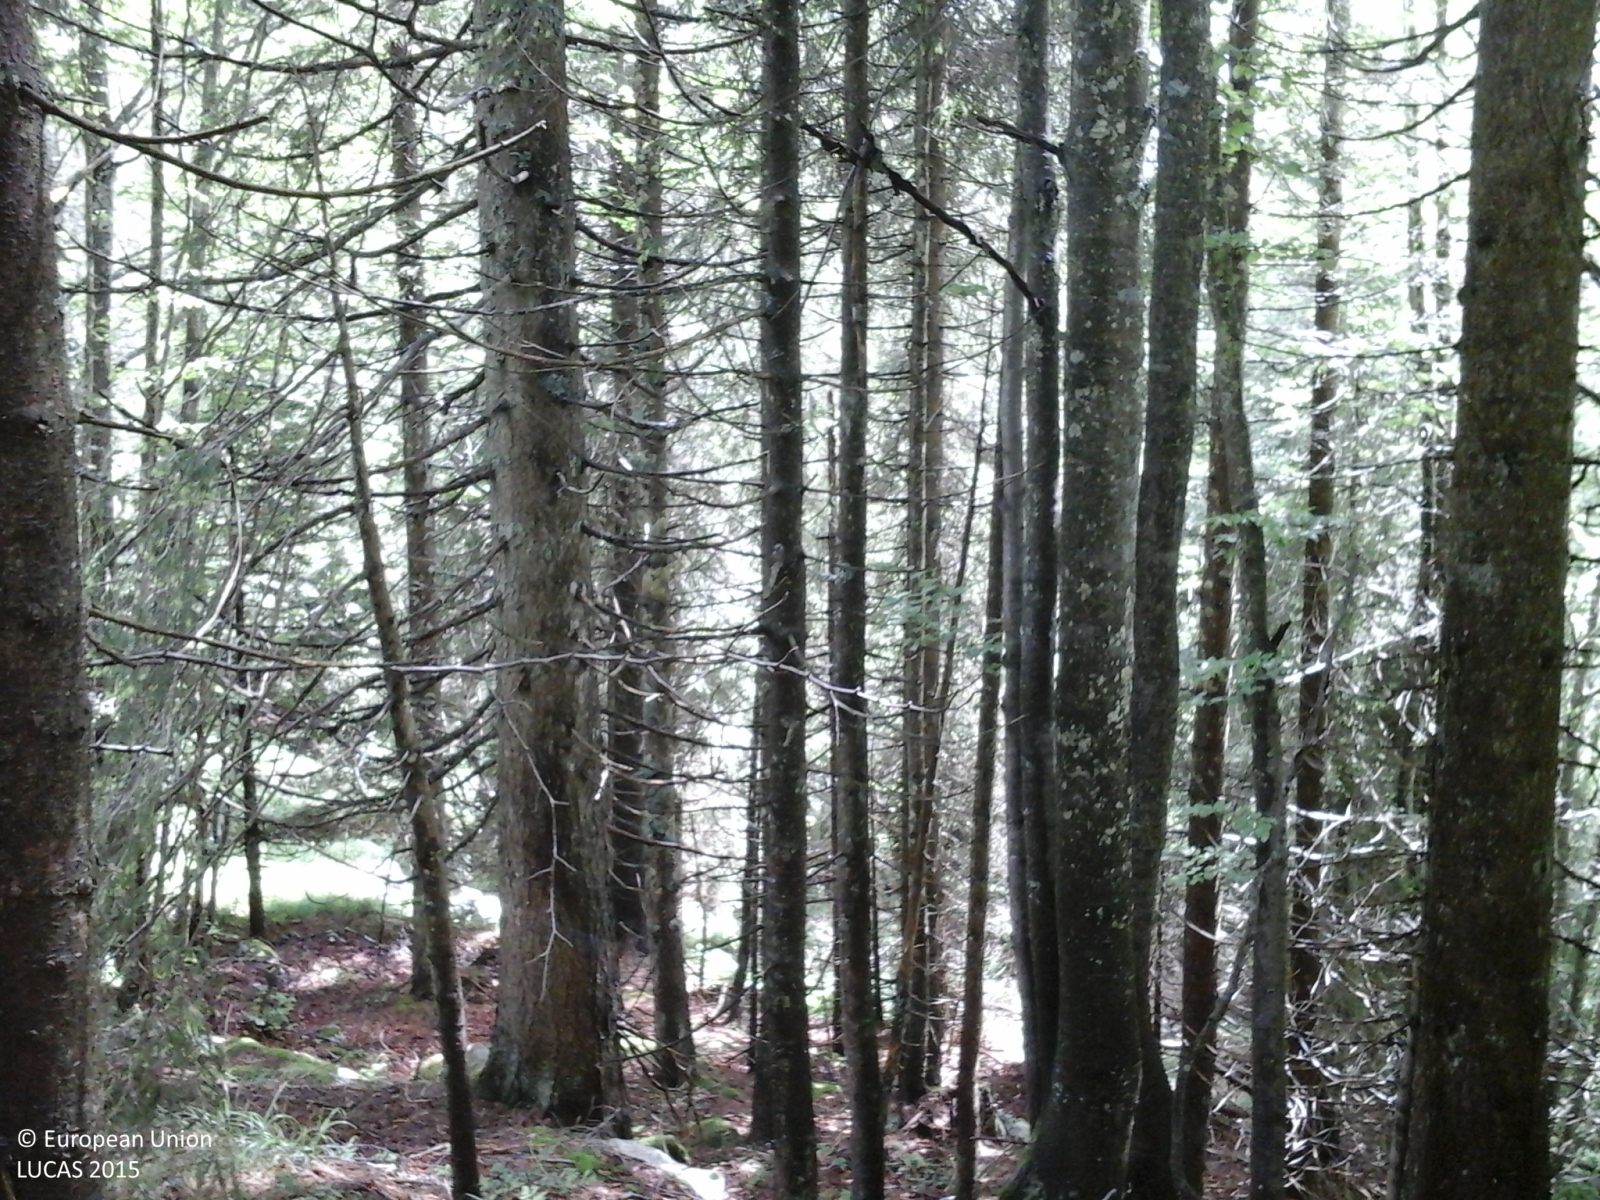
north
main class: Woodland
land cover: Spruce dominated coniferous woodland
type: alpine coniferous forest
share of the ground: > 75 %
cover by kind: coniferous forest trees 100 %
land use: Forestry
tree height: > 5 m
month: June
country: IT
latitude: 45.9438
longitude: 11.5328
